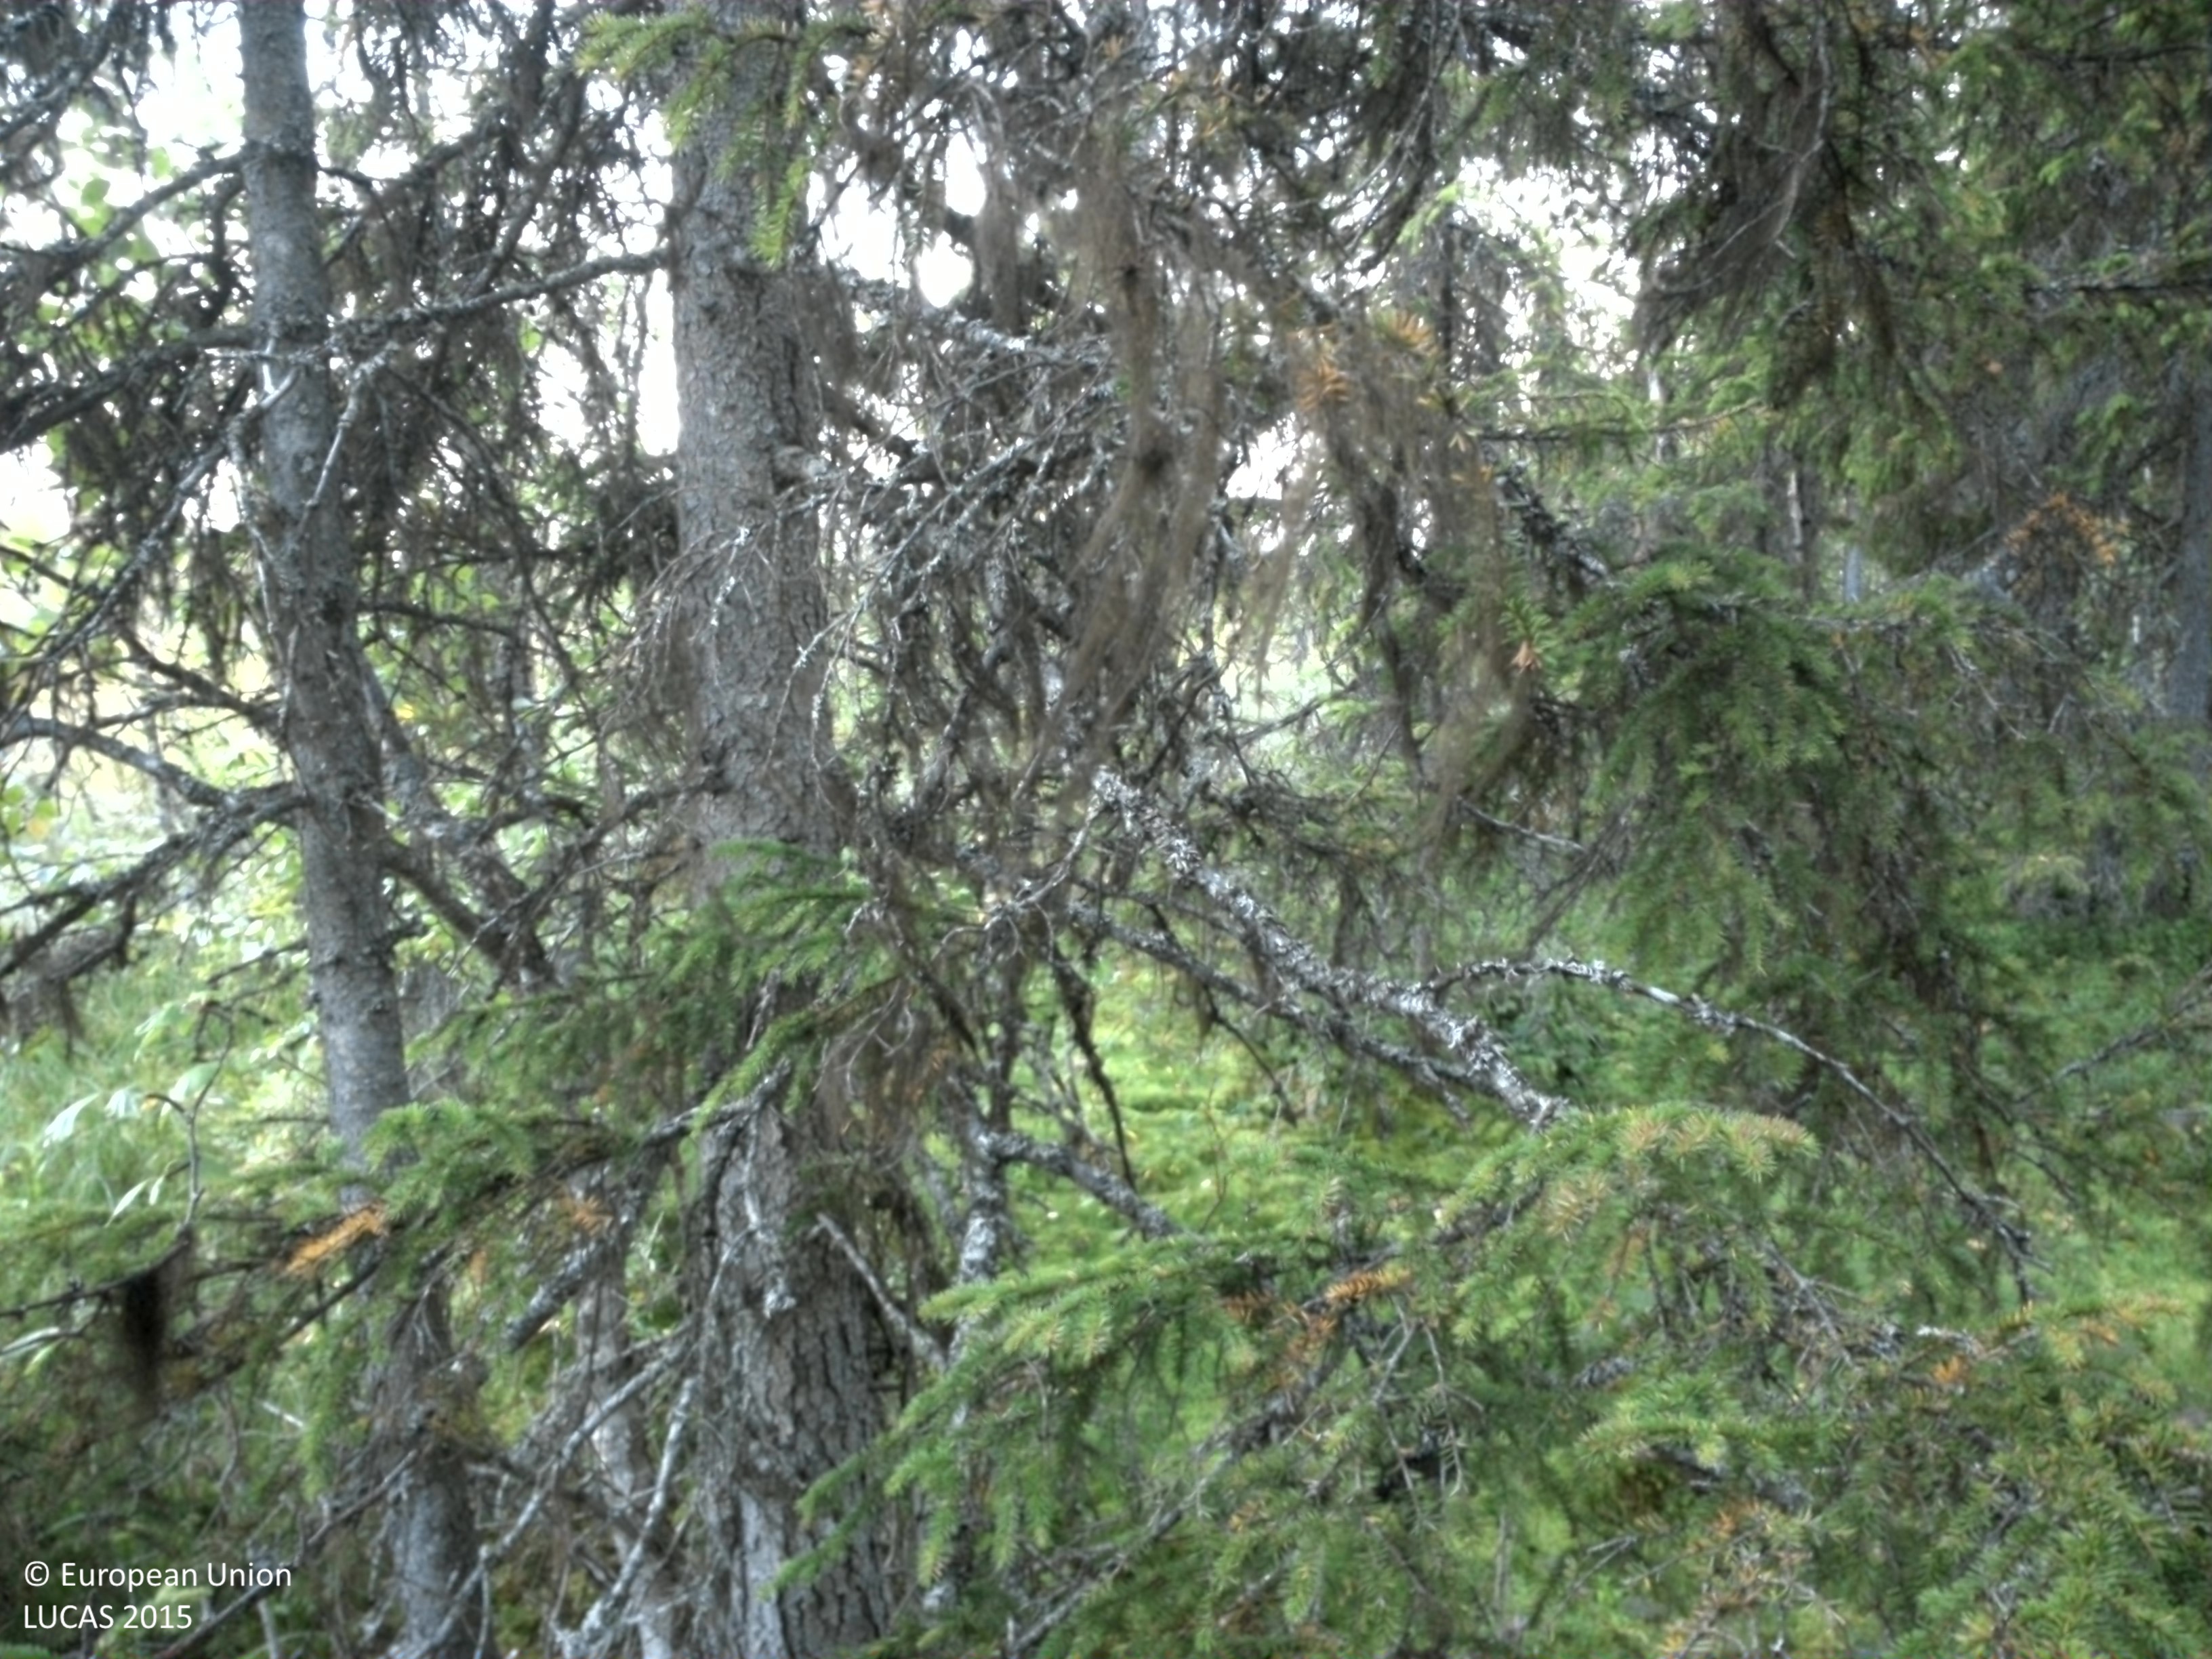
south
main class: Woodland
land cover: Spruce dominated mixed woodland
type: boreal forest
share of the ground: 25 - 50 %
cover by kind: shrubs 45 %, coniferous forest trees 20 %, lichens and mosses 20 %, broadleaved forest trees 10 %, herbaceous plants 5 %
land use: Forestry
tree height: > 5 m
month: August
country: SE
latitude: 64.7980
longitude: 16.7641
